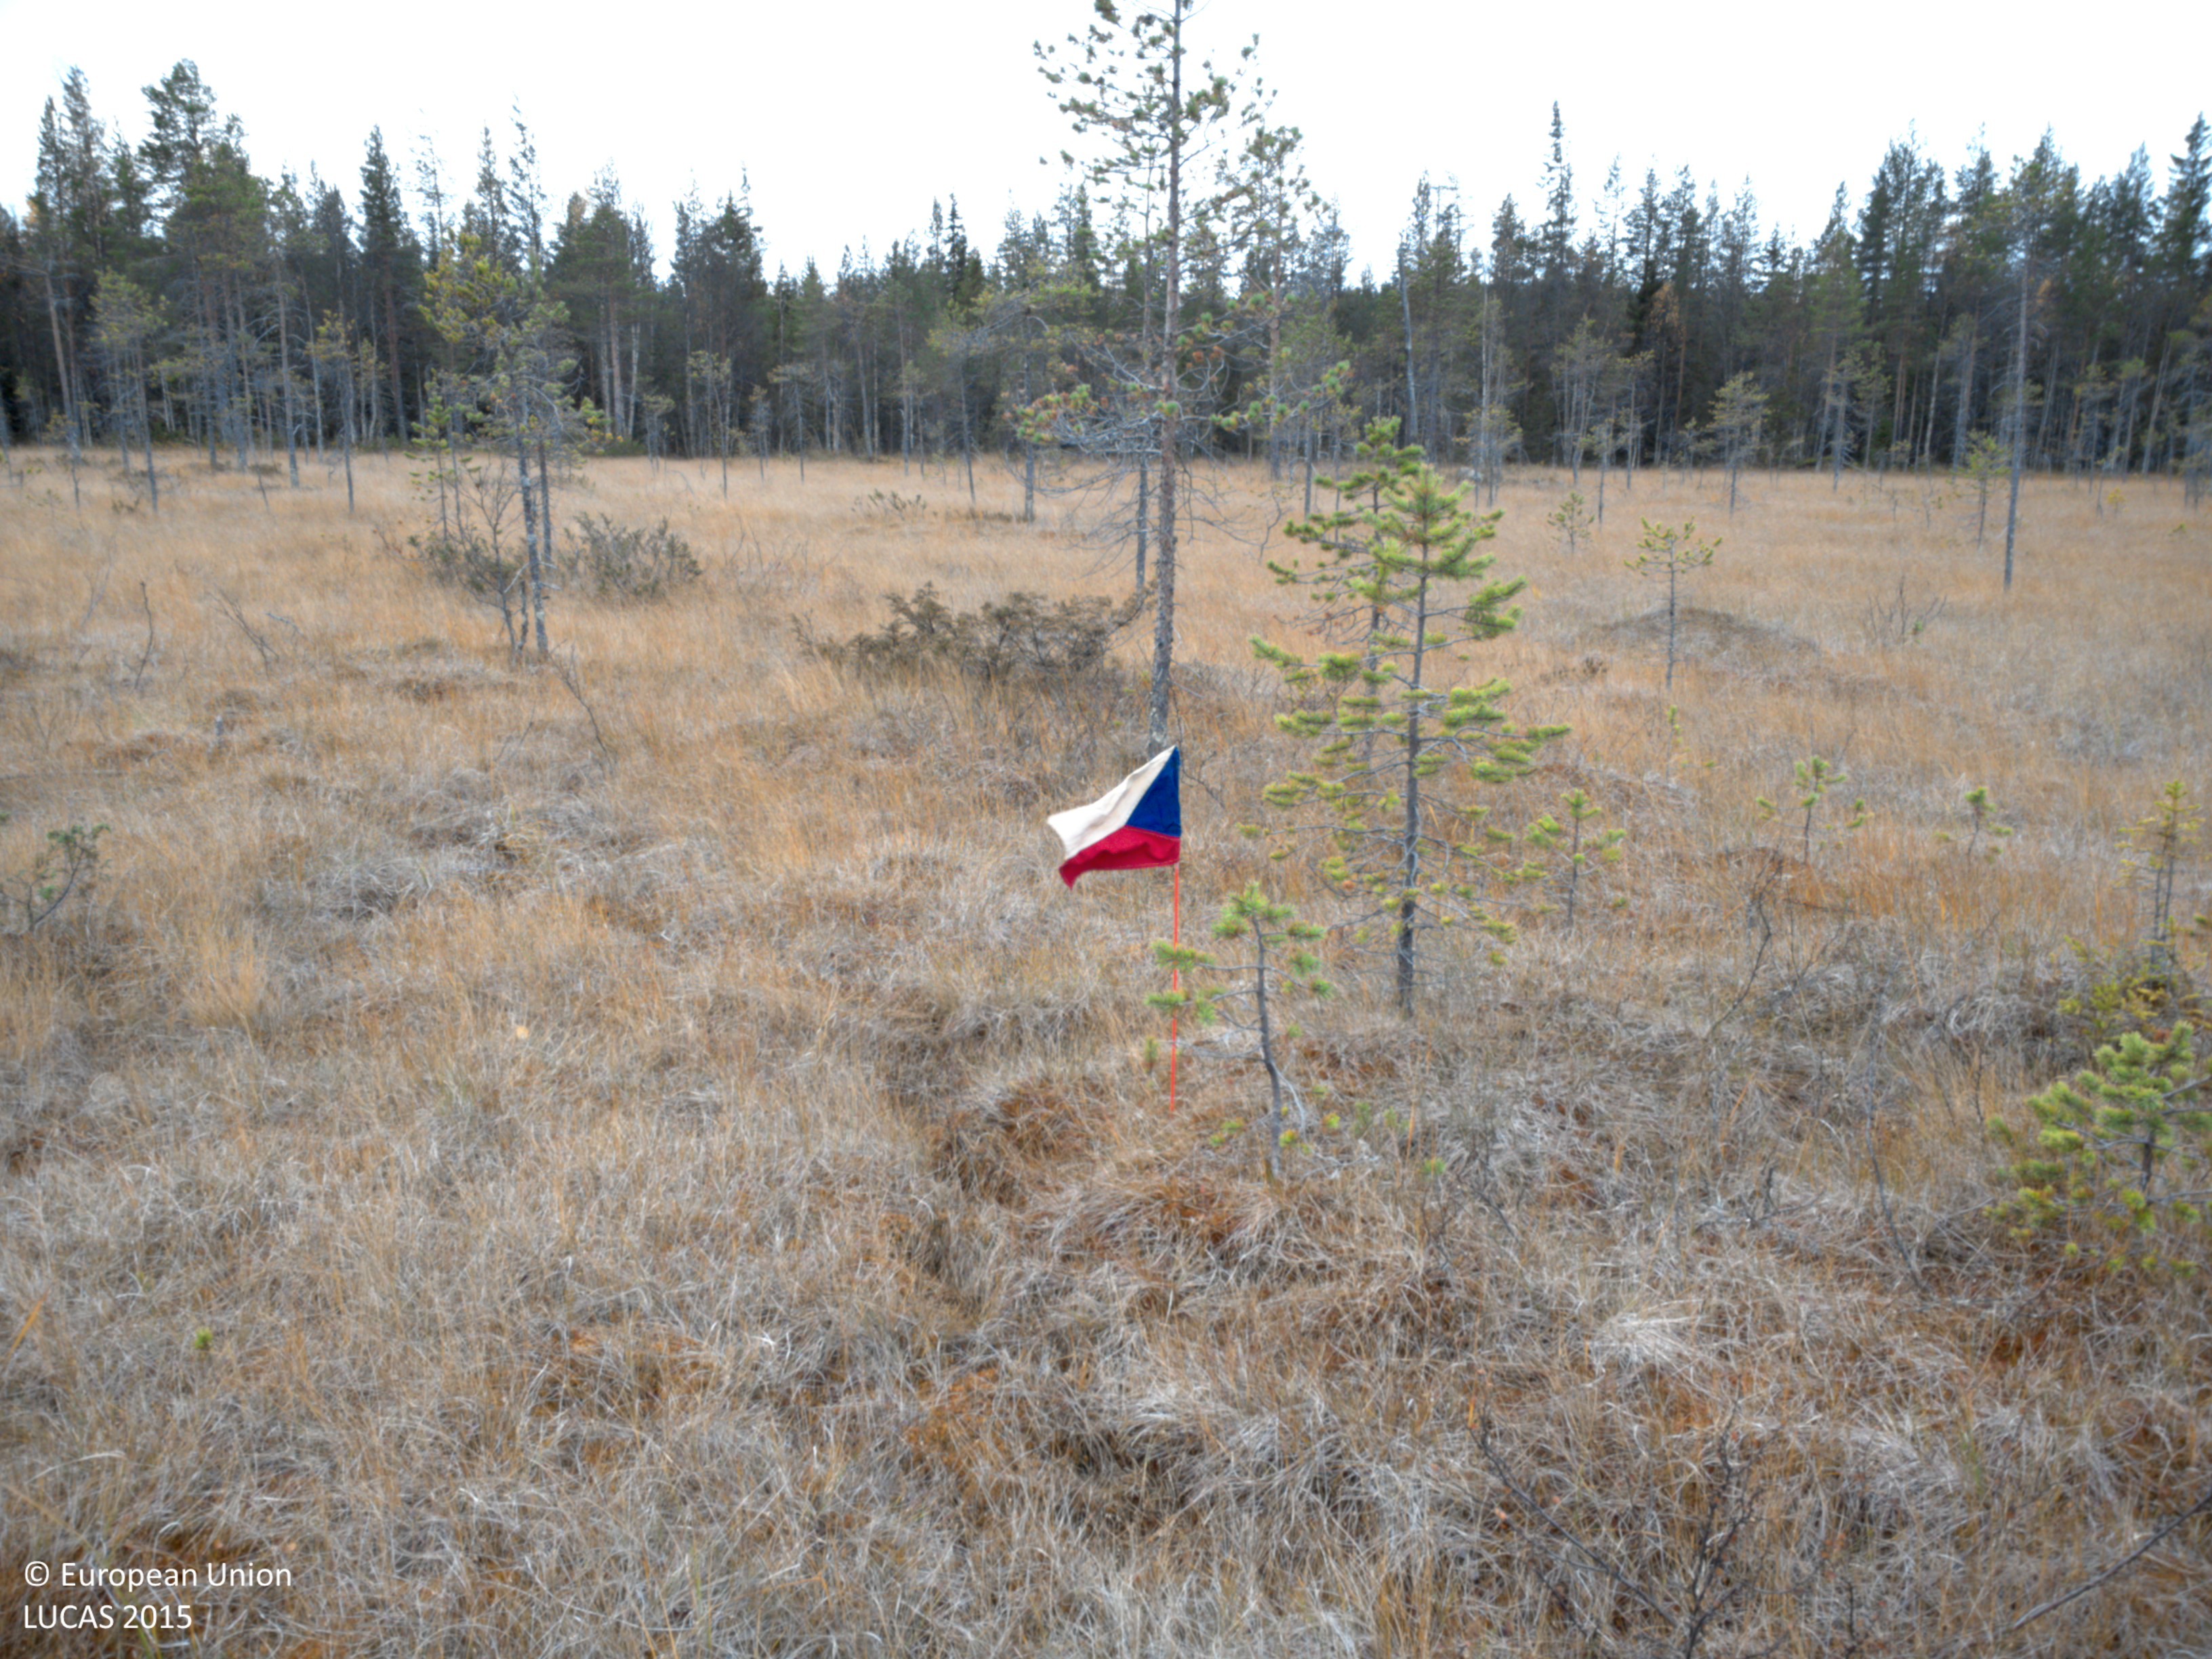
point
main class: Woodland
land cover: Pine dominated coniferous woodland
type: boreal forest
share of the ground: 10 - 25 %
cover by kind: herbaceous plants 45 %, shrubs 25 %, coniferous forest trees 15 %, lichens and mosses 15 %
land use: Semi-natural and natural areas not in use
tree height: < 5 m
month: October
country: SE
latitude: 65.0211
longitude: 18.2196
